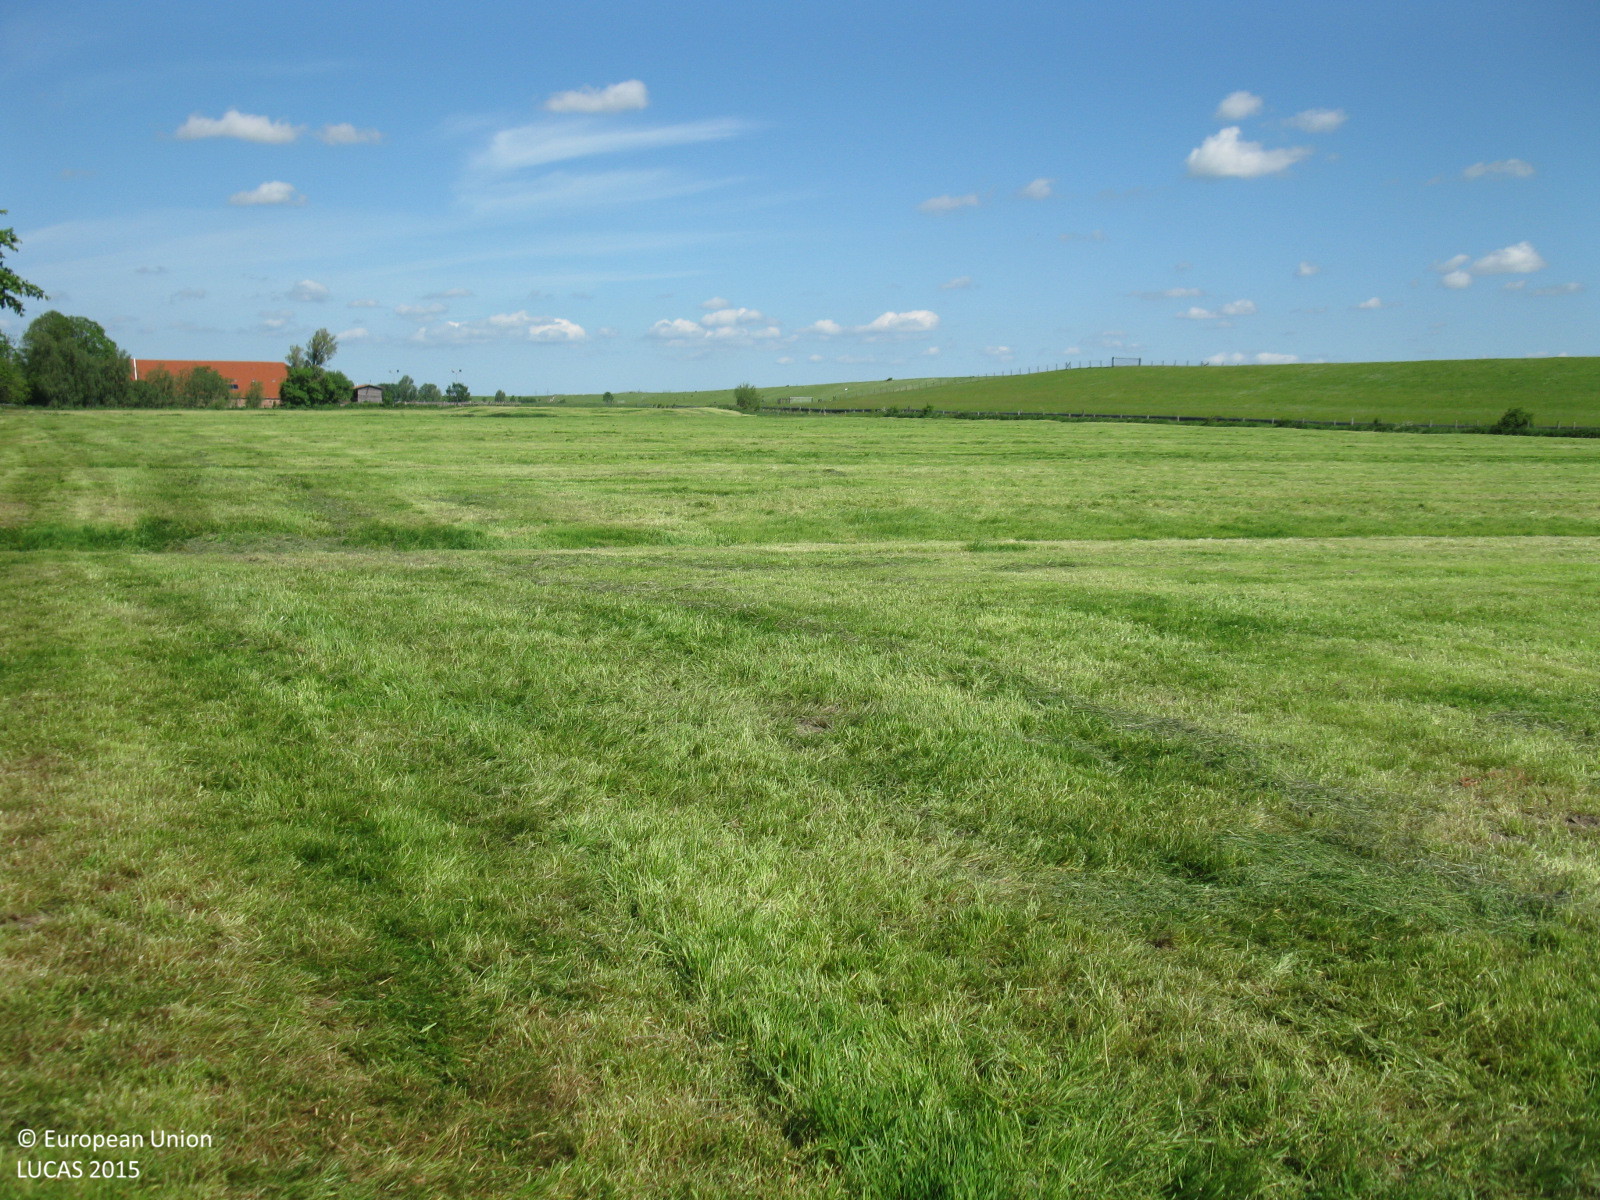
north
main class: Grassland
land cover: Grassland without tree/shrub cover
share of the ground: > 75 %
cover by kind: herbaceous plants 100 %
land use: Agriculture (excluding fallow land and kitchen gardens)
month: June
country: DE
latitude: 53.3009
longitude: 7.3447
